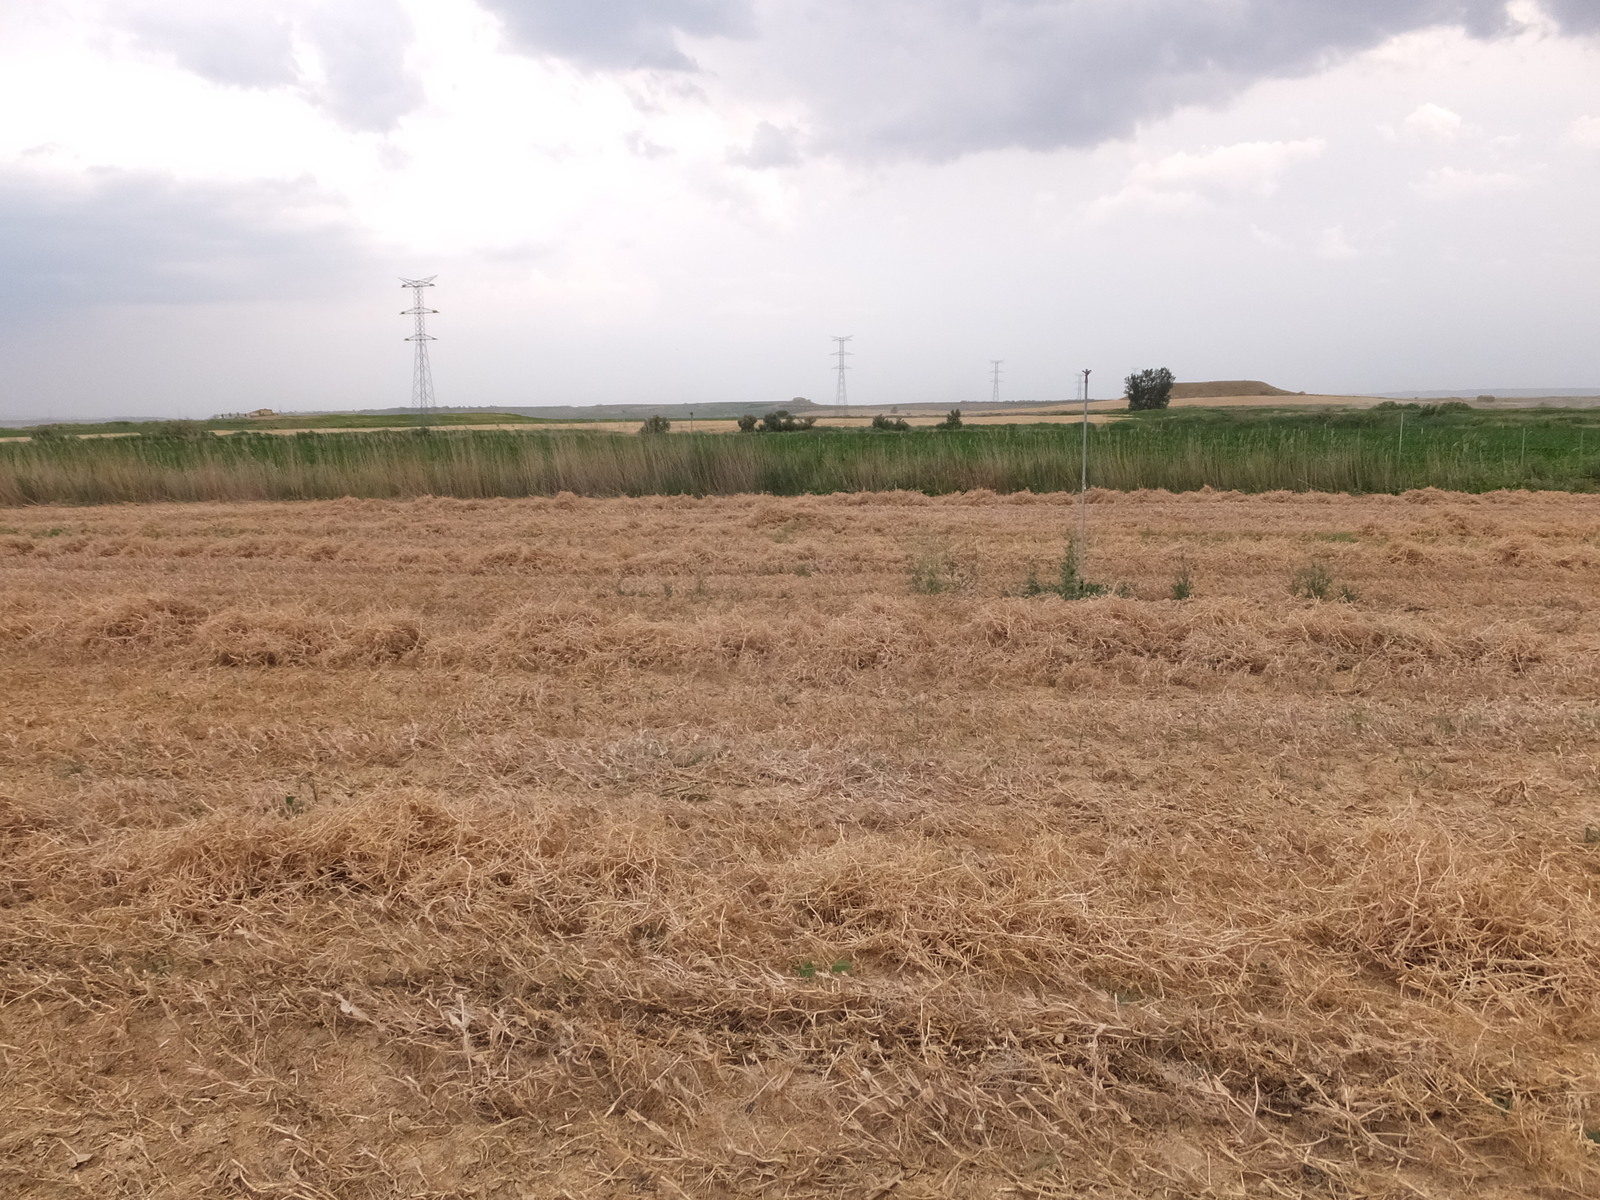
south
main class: Cropland
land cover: Dry pulses
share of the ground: < 10 %
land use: Agriculture (excluding fallow land and kitchen gardens)
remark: Harvested field
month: June
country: ES
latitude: 41.8199
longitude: 0.0752
